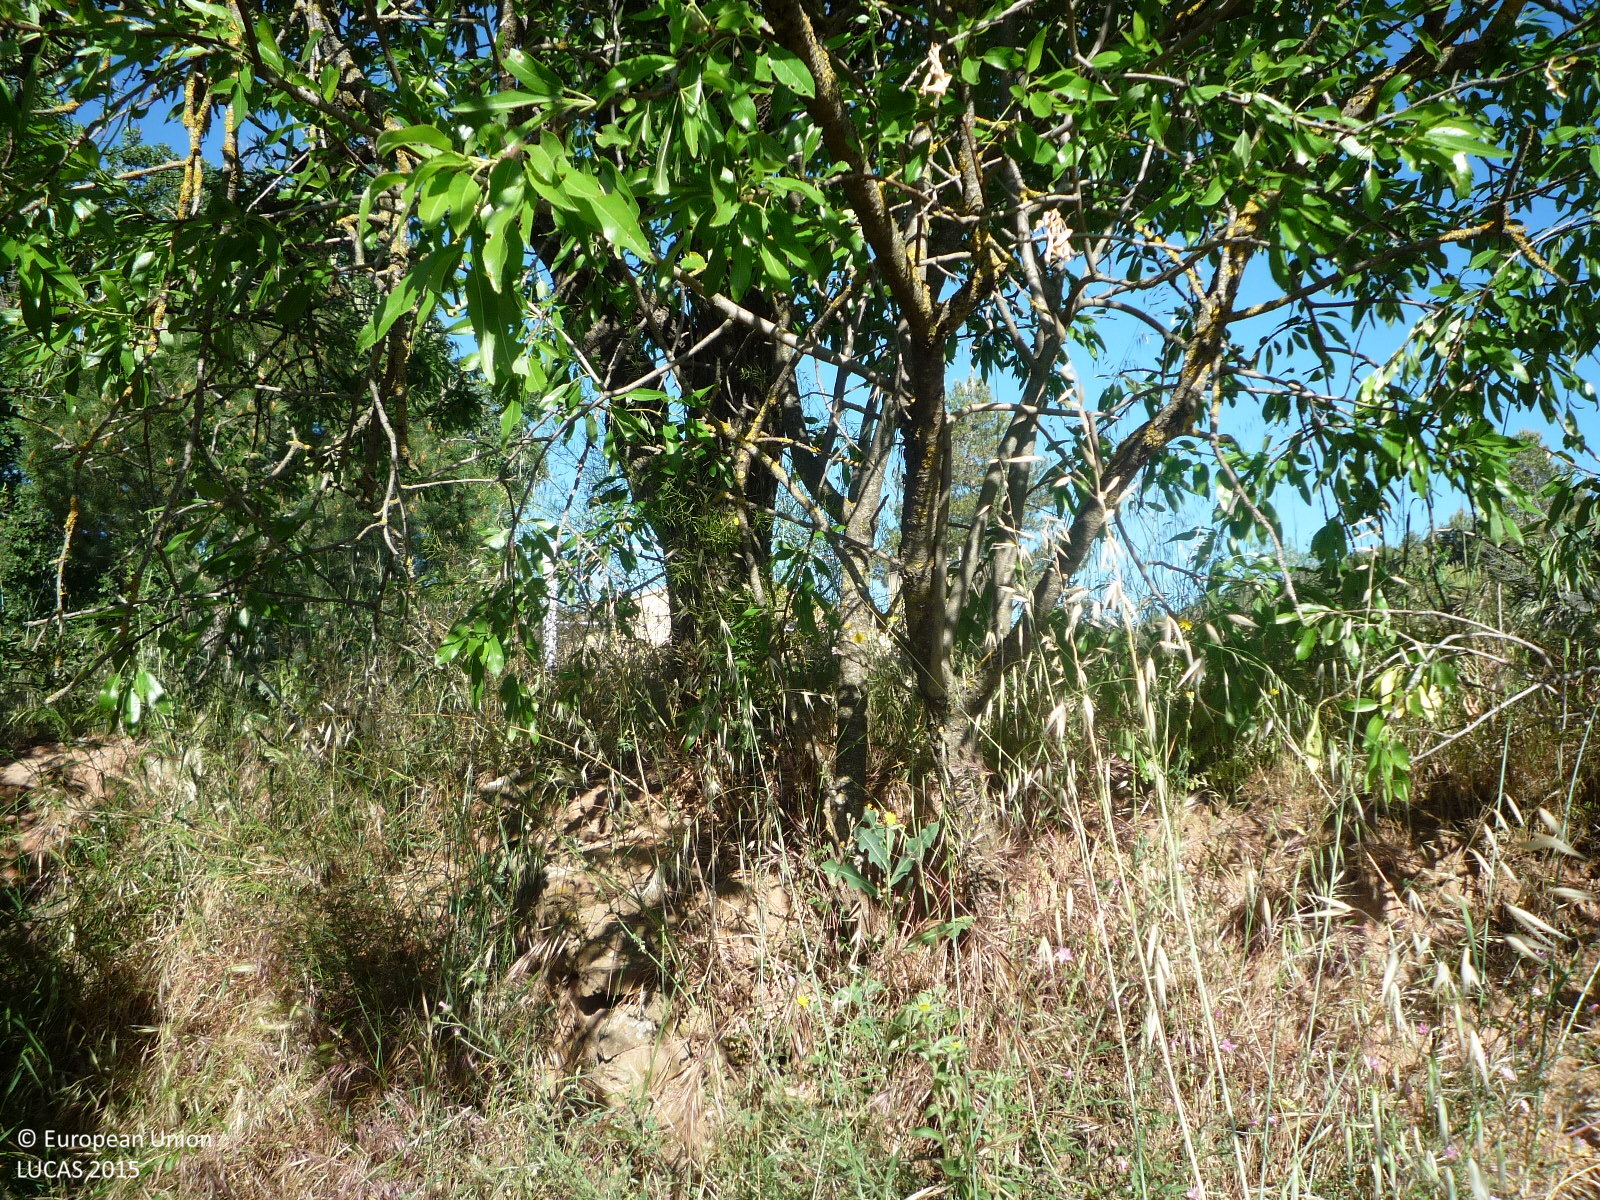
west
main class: Shrubland
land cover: Shrubland with sparse tree cover
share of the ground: 50 - 75 %
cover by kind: shrubs 60 %, herbaceous plants 35 %, broadleaved forest trees 5 %
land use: Semi-natural and natural areas not in use
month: May
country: ES
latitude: 41.8922
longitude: 1.6613
